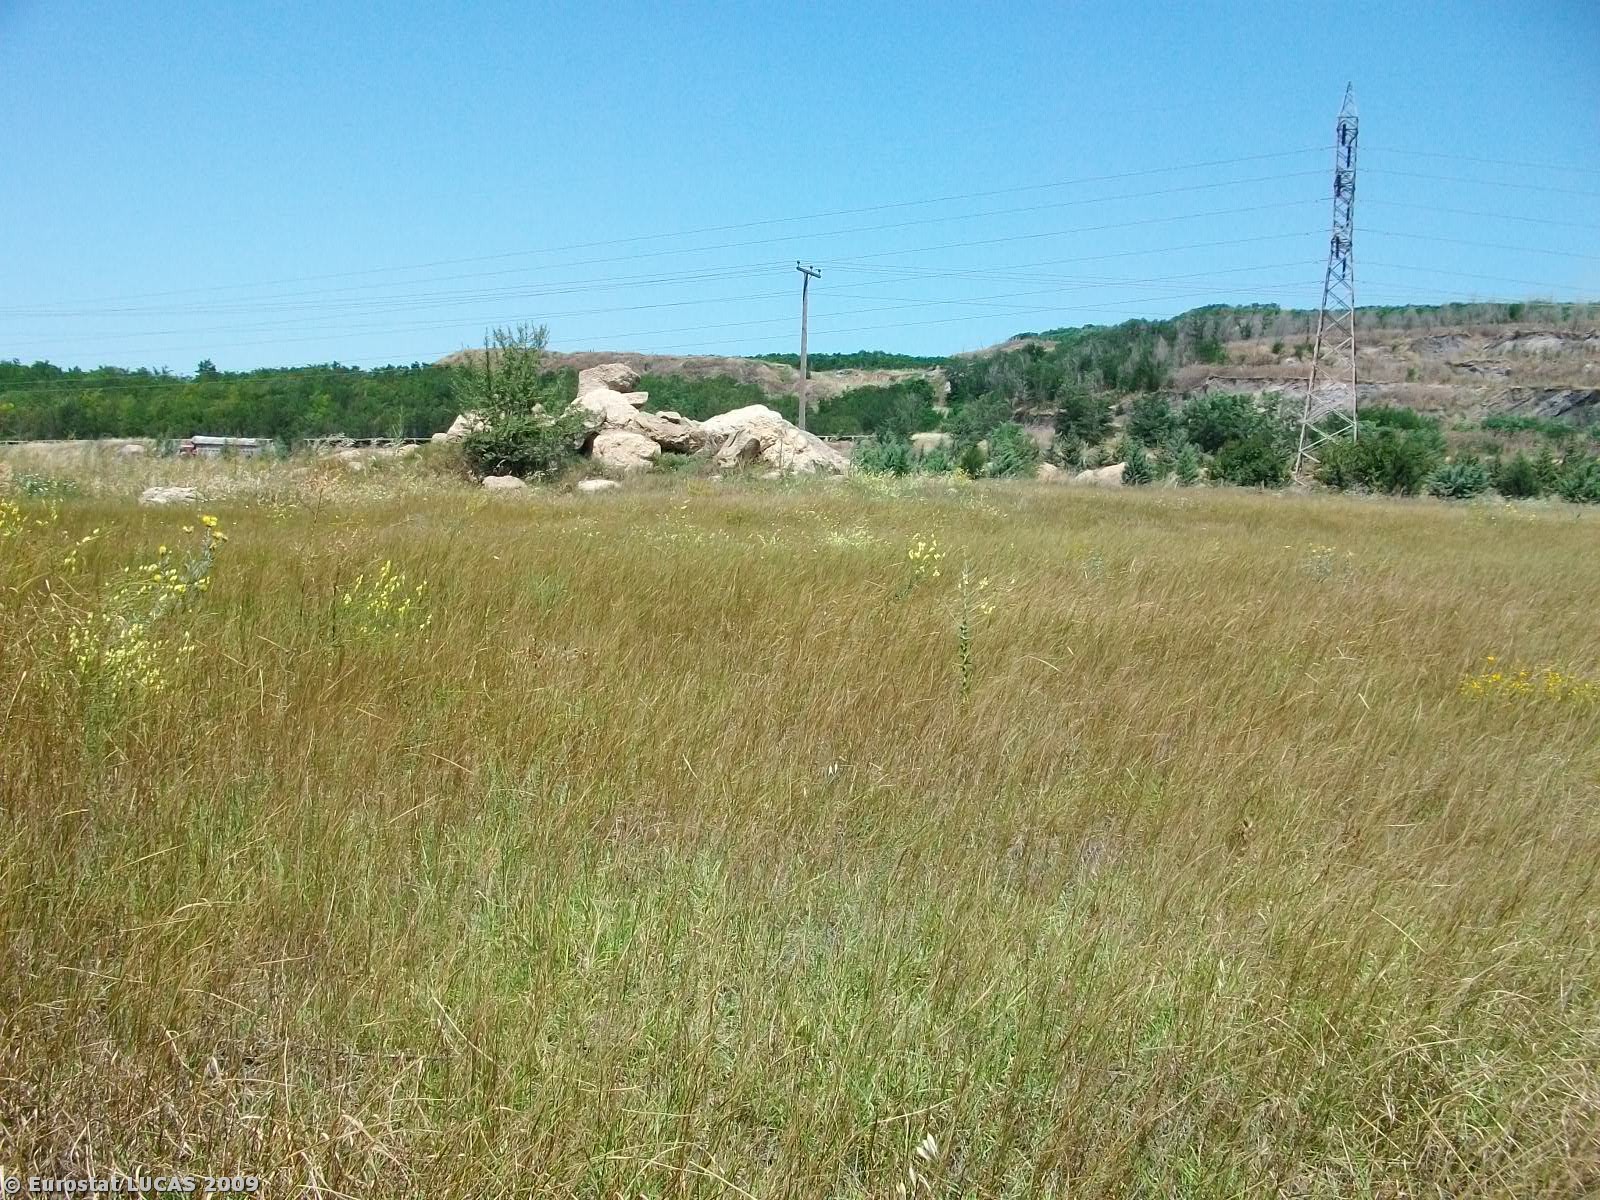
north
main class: Grassland
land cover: Grassland without tree/shrub cover
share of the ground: > 75 %
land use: Unused
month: July
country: GR
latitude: 40.4629
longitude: 21.8226
